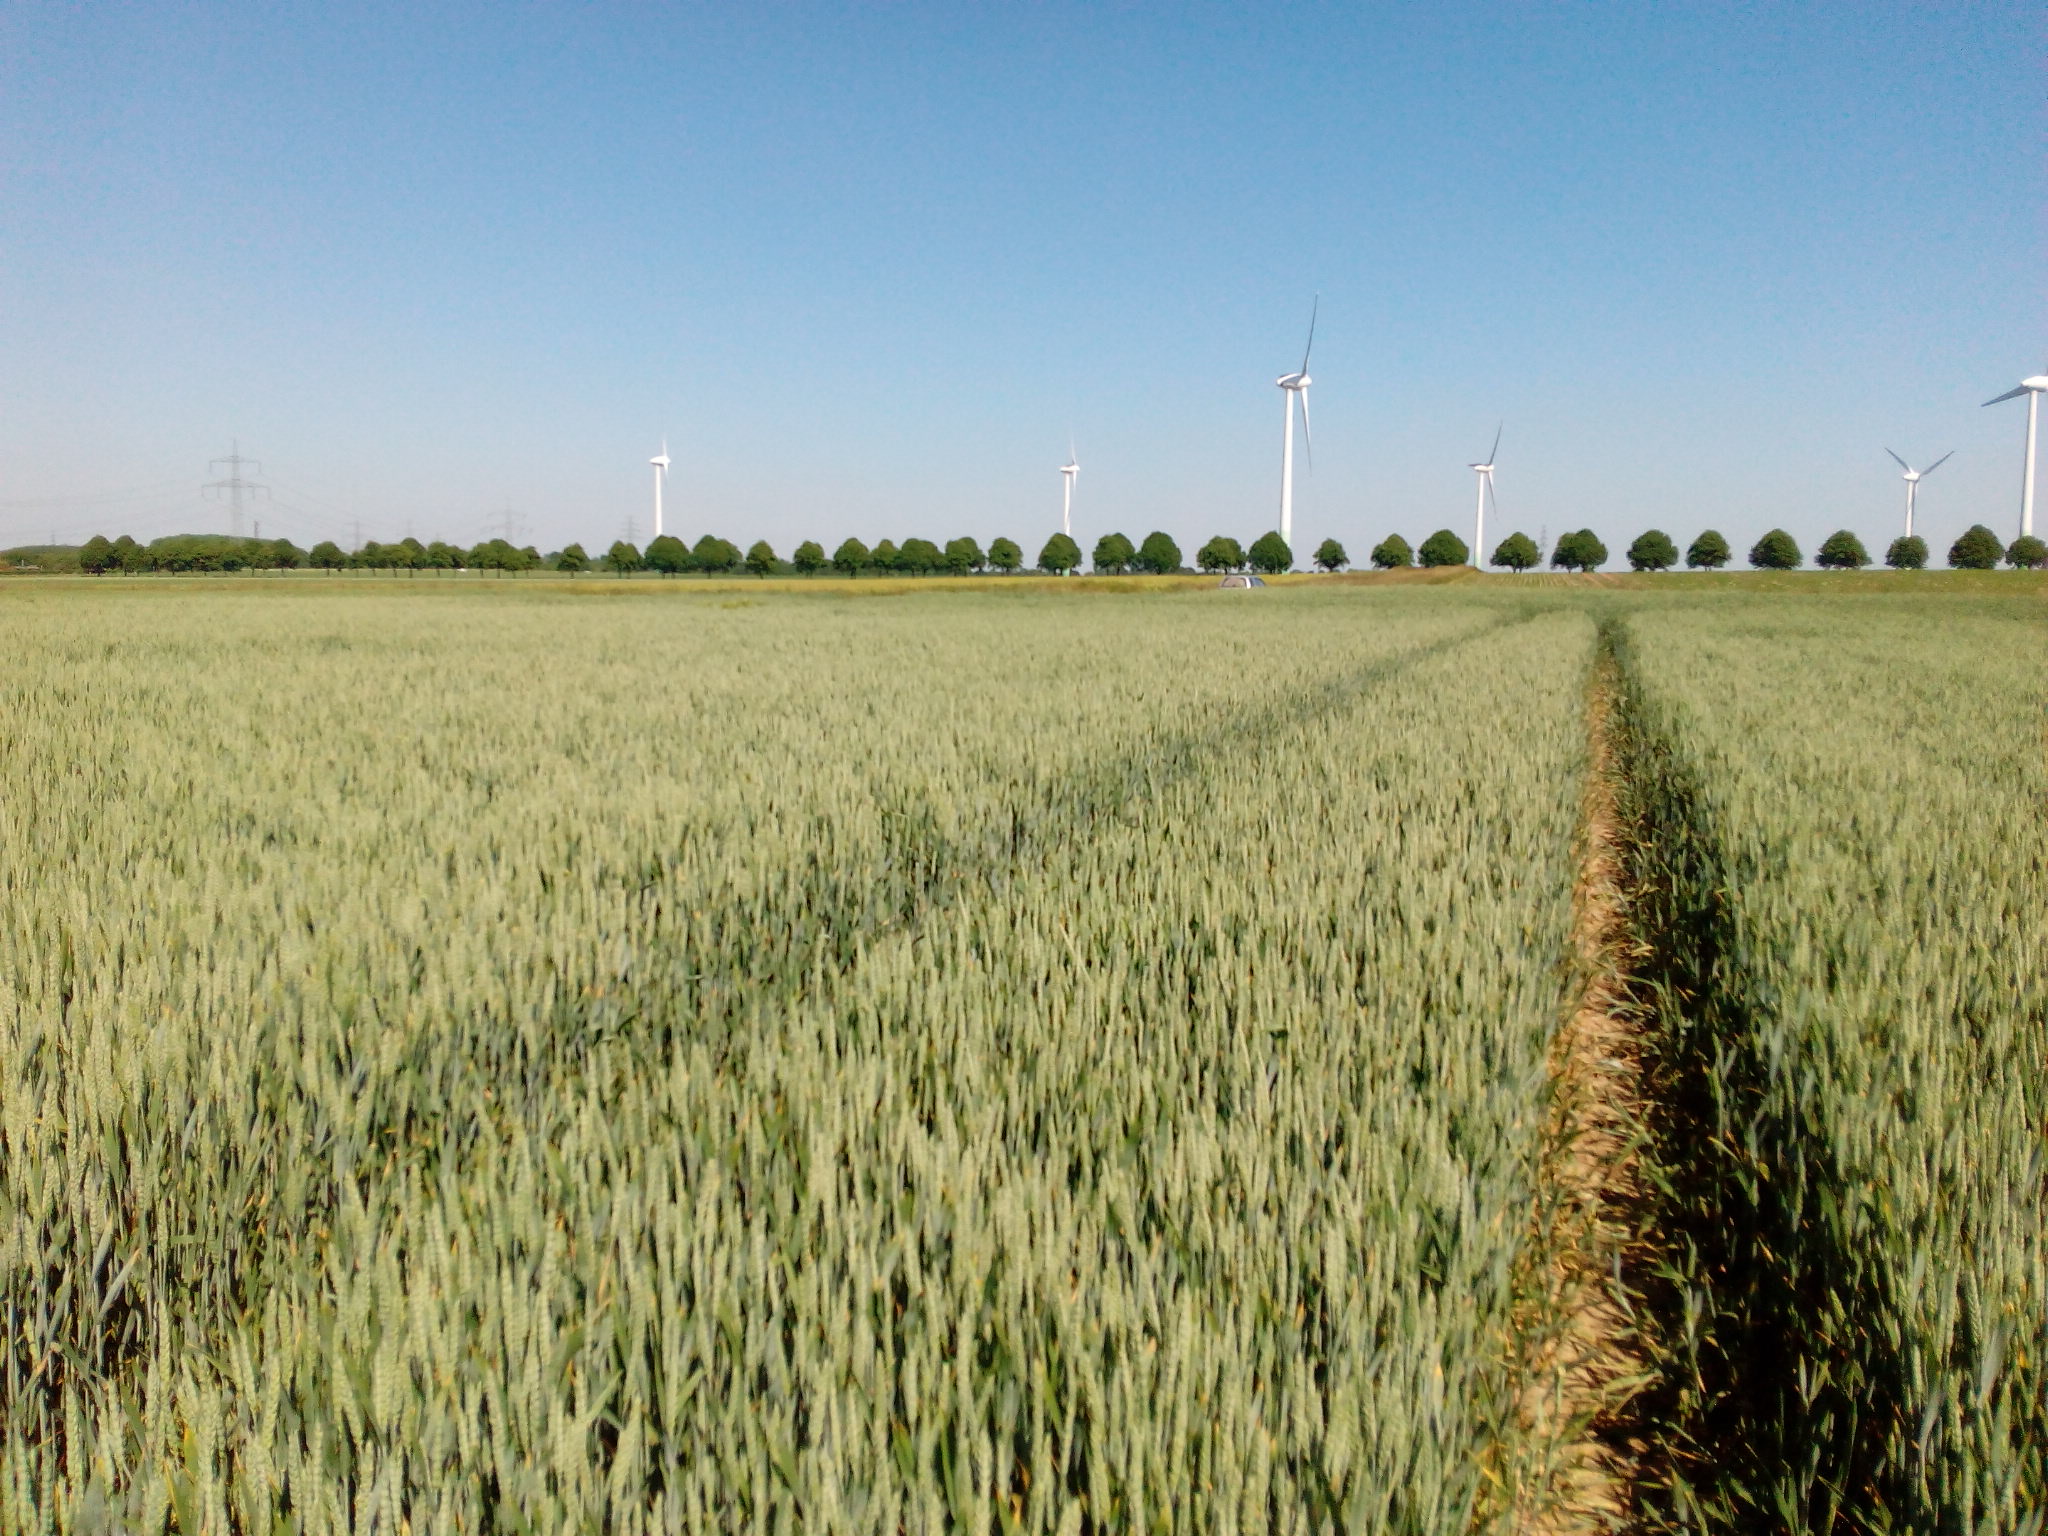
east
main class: Cropland
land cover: Common wheat
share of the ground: > 75 %
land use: Agriculture (excluding fallow land and kitchen gardens)
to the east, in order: Common wheat; Grass margins; Tracks; Grass margins; Sugar beet
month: June
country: DE
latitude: 52.2696
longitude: 9.8975
